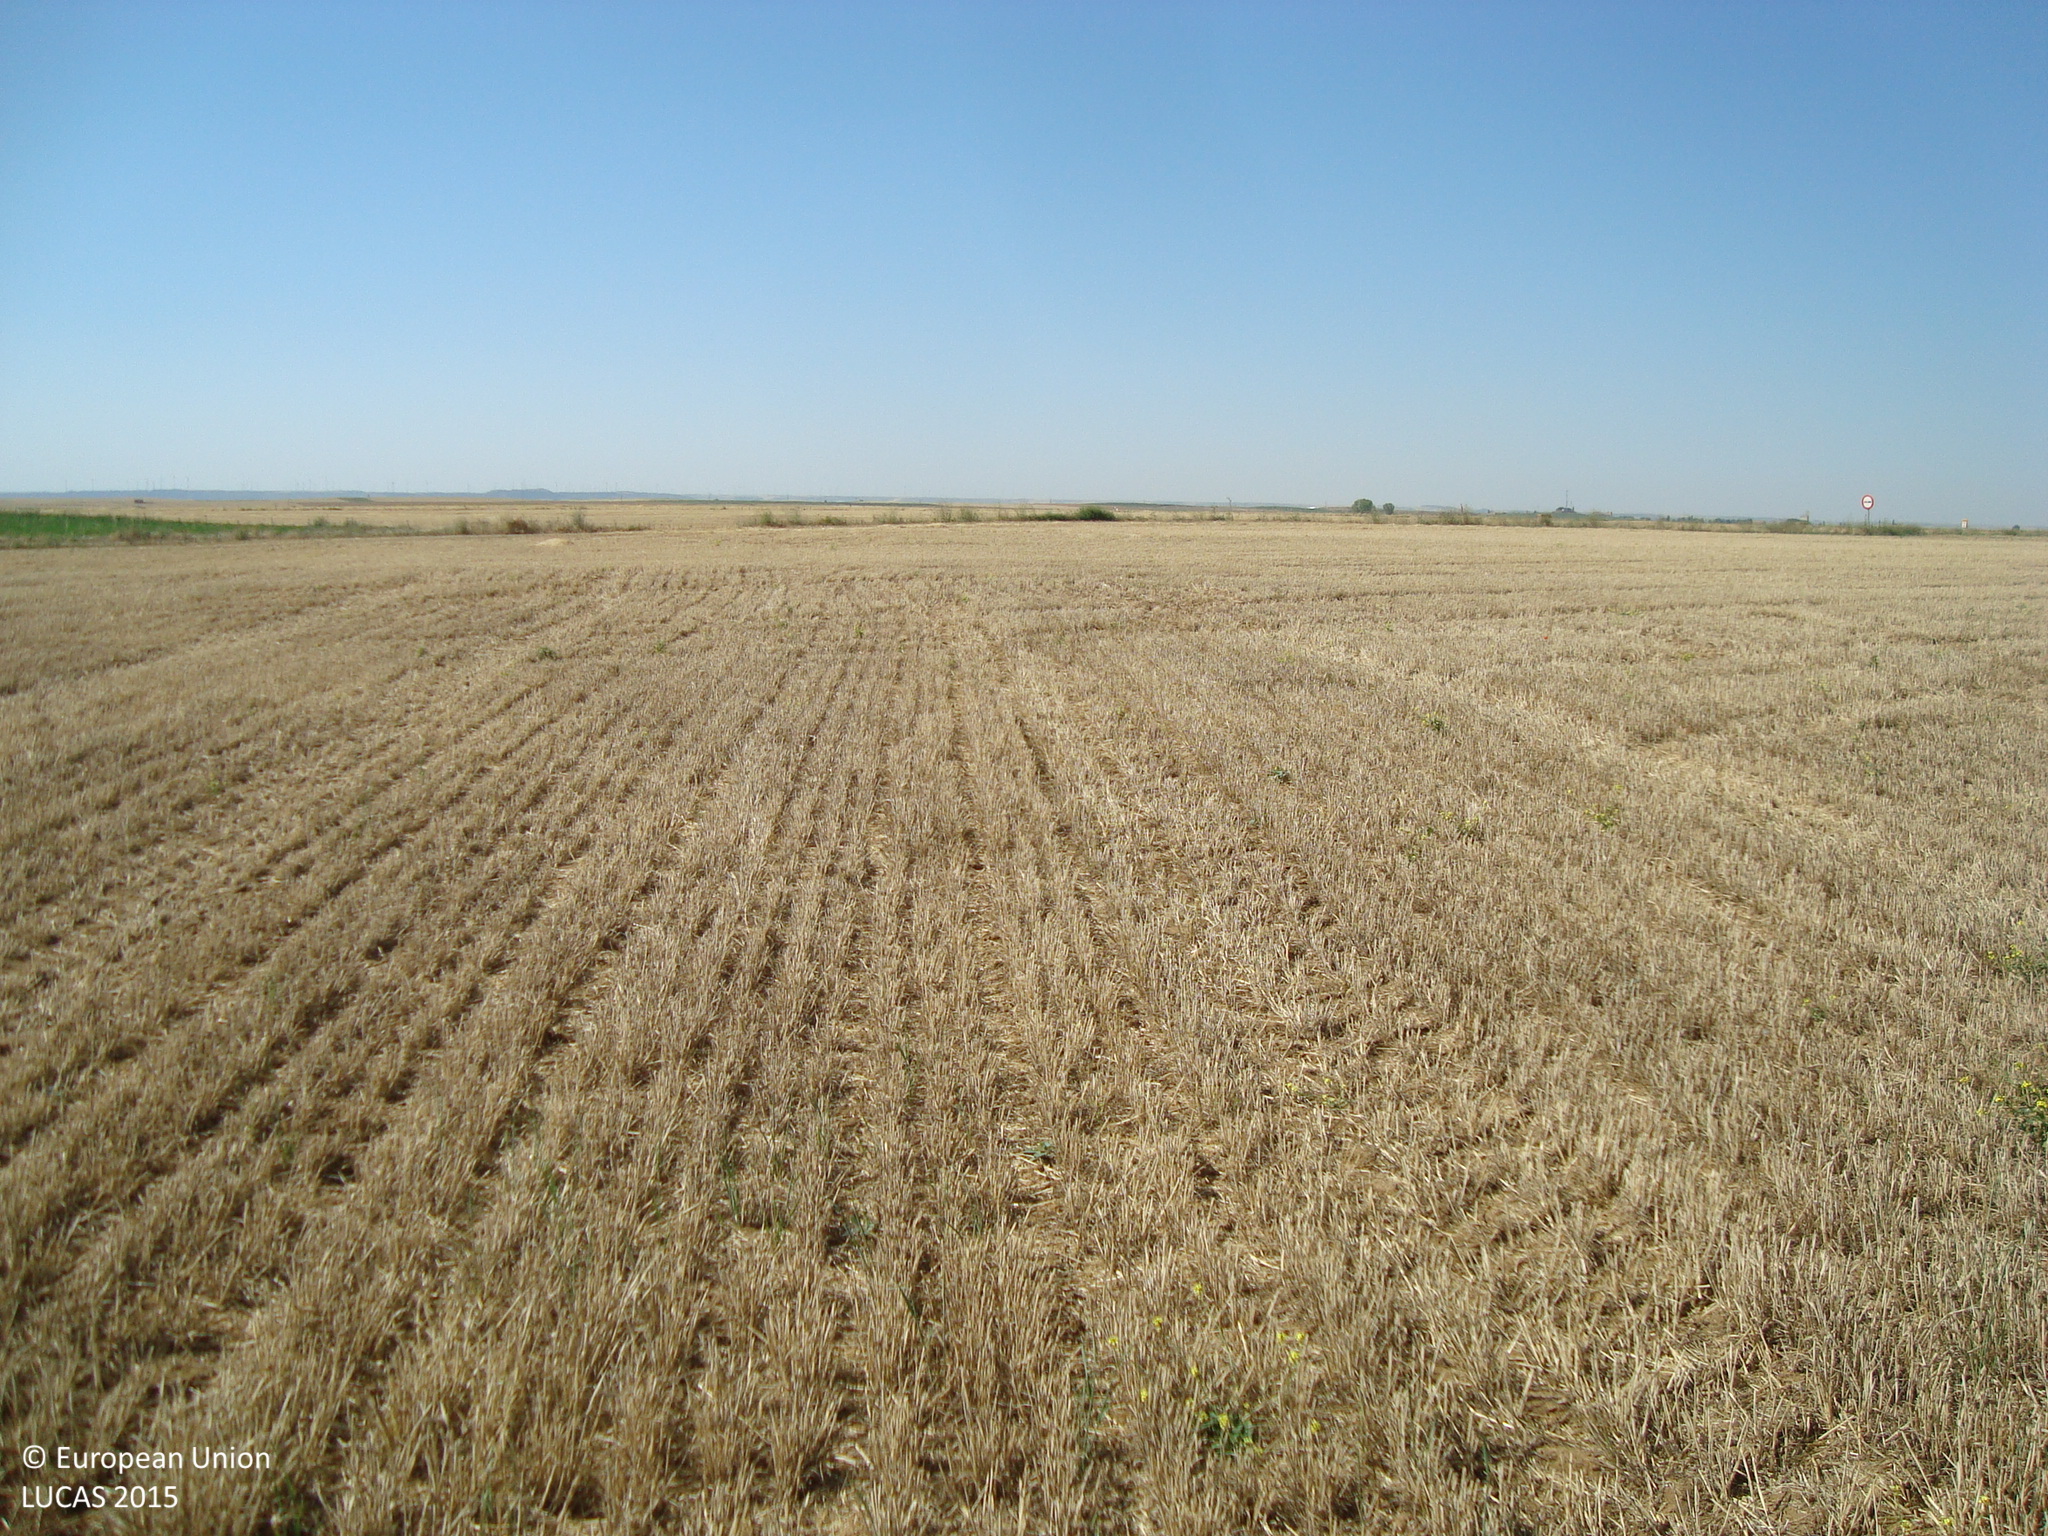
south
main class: Cropland
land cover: Barley
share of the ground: < 10 %
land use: Agriculture (excluding fallow land and kitchen gardens)
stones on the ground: < 10 %
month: July
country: ES
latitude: 42.0718
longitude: -4.8091
